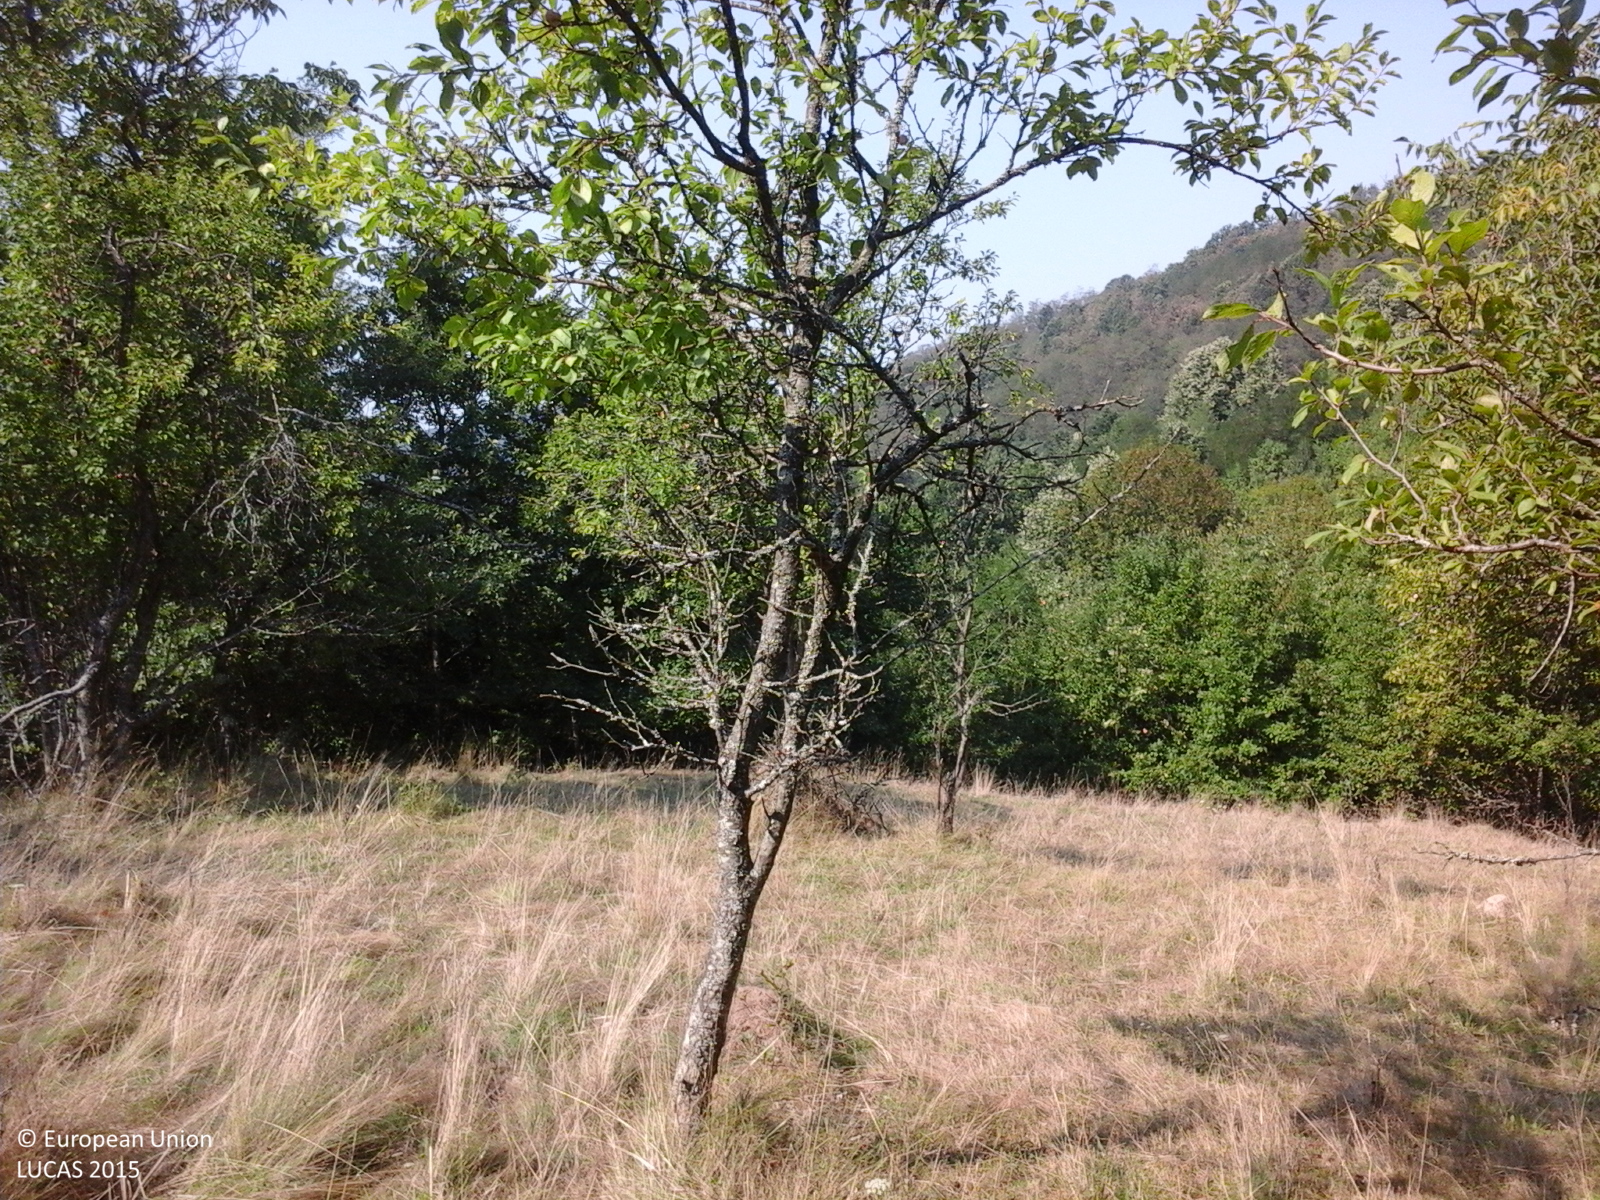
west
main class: Cropland
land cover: Other fruit trees and berries
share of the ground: > 75 %
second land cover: Grassland without tree/shrub cover
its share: 50 - 75 %
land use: Agriculture (excluding fallow land and kitchen gardens)
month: August
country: RO
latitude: 46.1512
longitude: 22.8865
